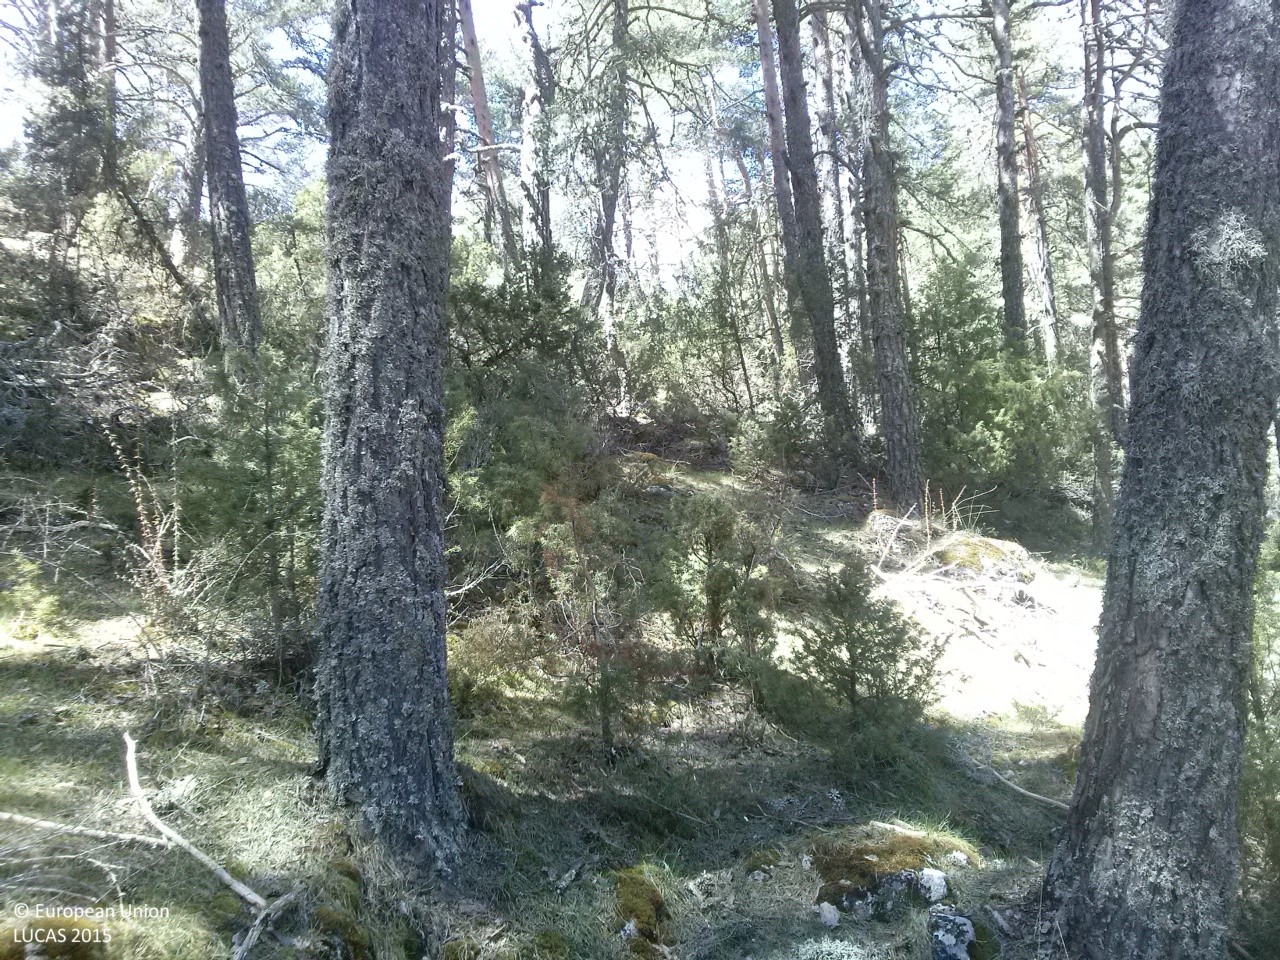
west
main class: Woodland
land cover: Pine dominated coniferous woodland
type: coniferous forest of the mediterranean region
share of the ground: > 75 %
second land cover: Grassland without tree/shrub cover
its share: > 75 %
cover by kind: coniferous forest trees 80 %, herbaceous plants 20 %
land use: Forestry
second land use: Agriculture (excluding fallow land and kitchen gardens)
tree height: > 5 m
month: April
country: ES
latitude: 40.4329
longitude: -1.7694
